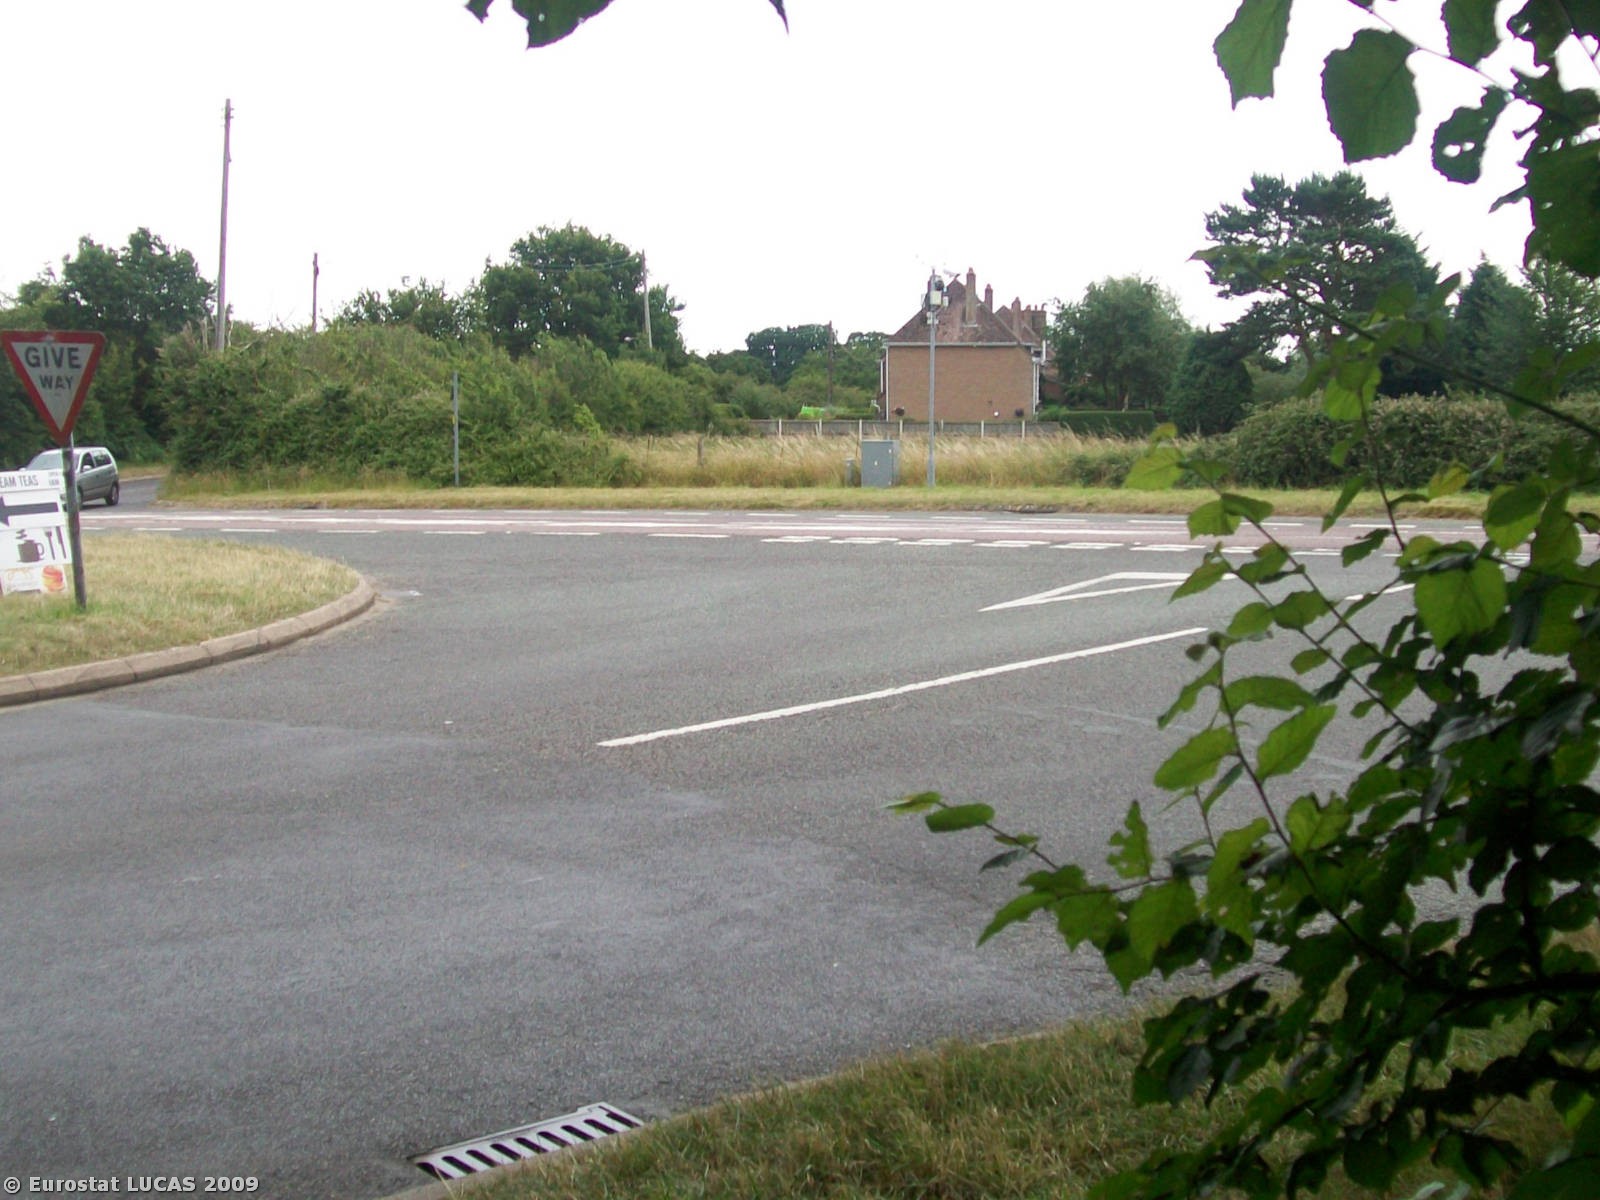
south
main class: Grassland
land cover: Grassland without tree/shrub cover
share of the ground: > 75 %
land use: Agriculture (excluding fallow land and kitchen gardens)
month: July
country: GB
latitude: 50.7384
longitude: -2.0898
